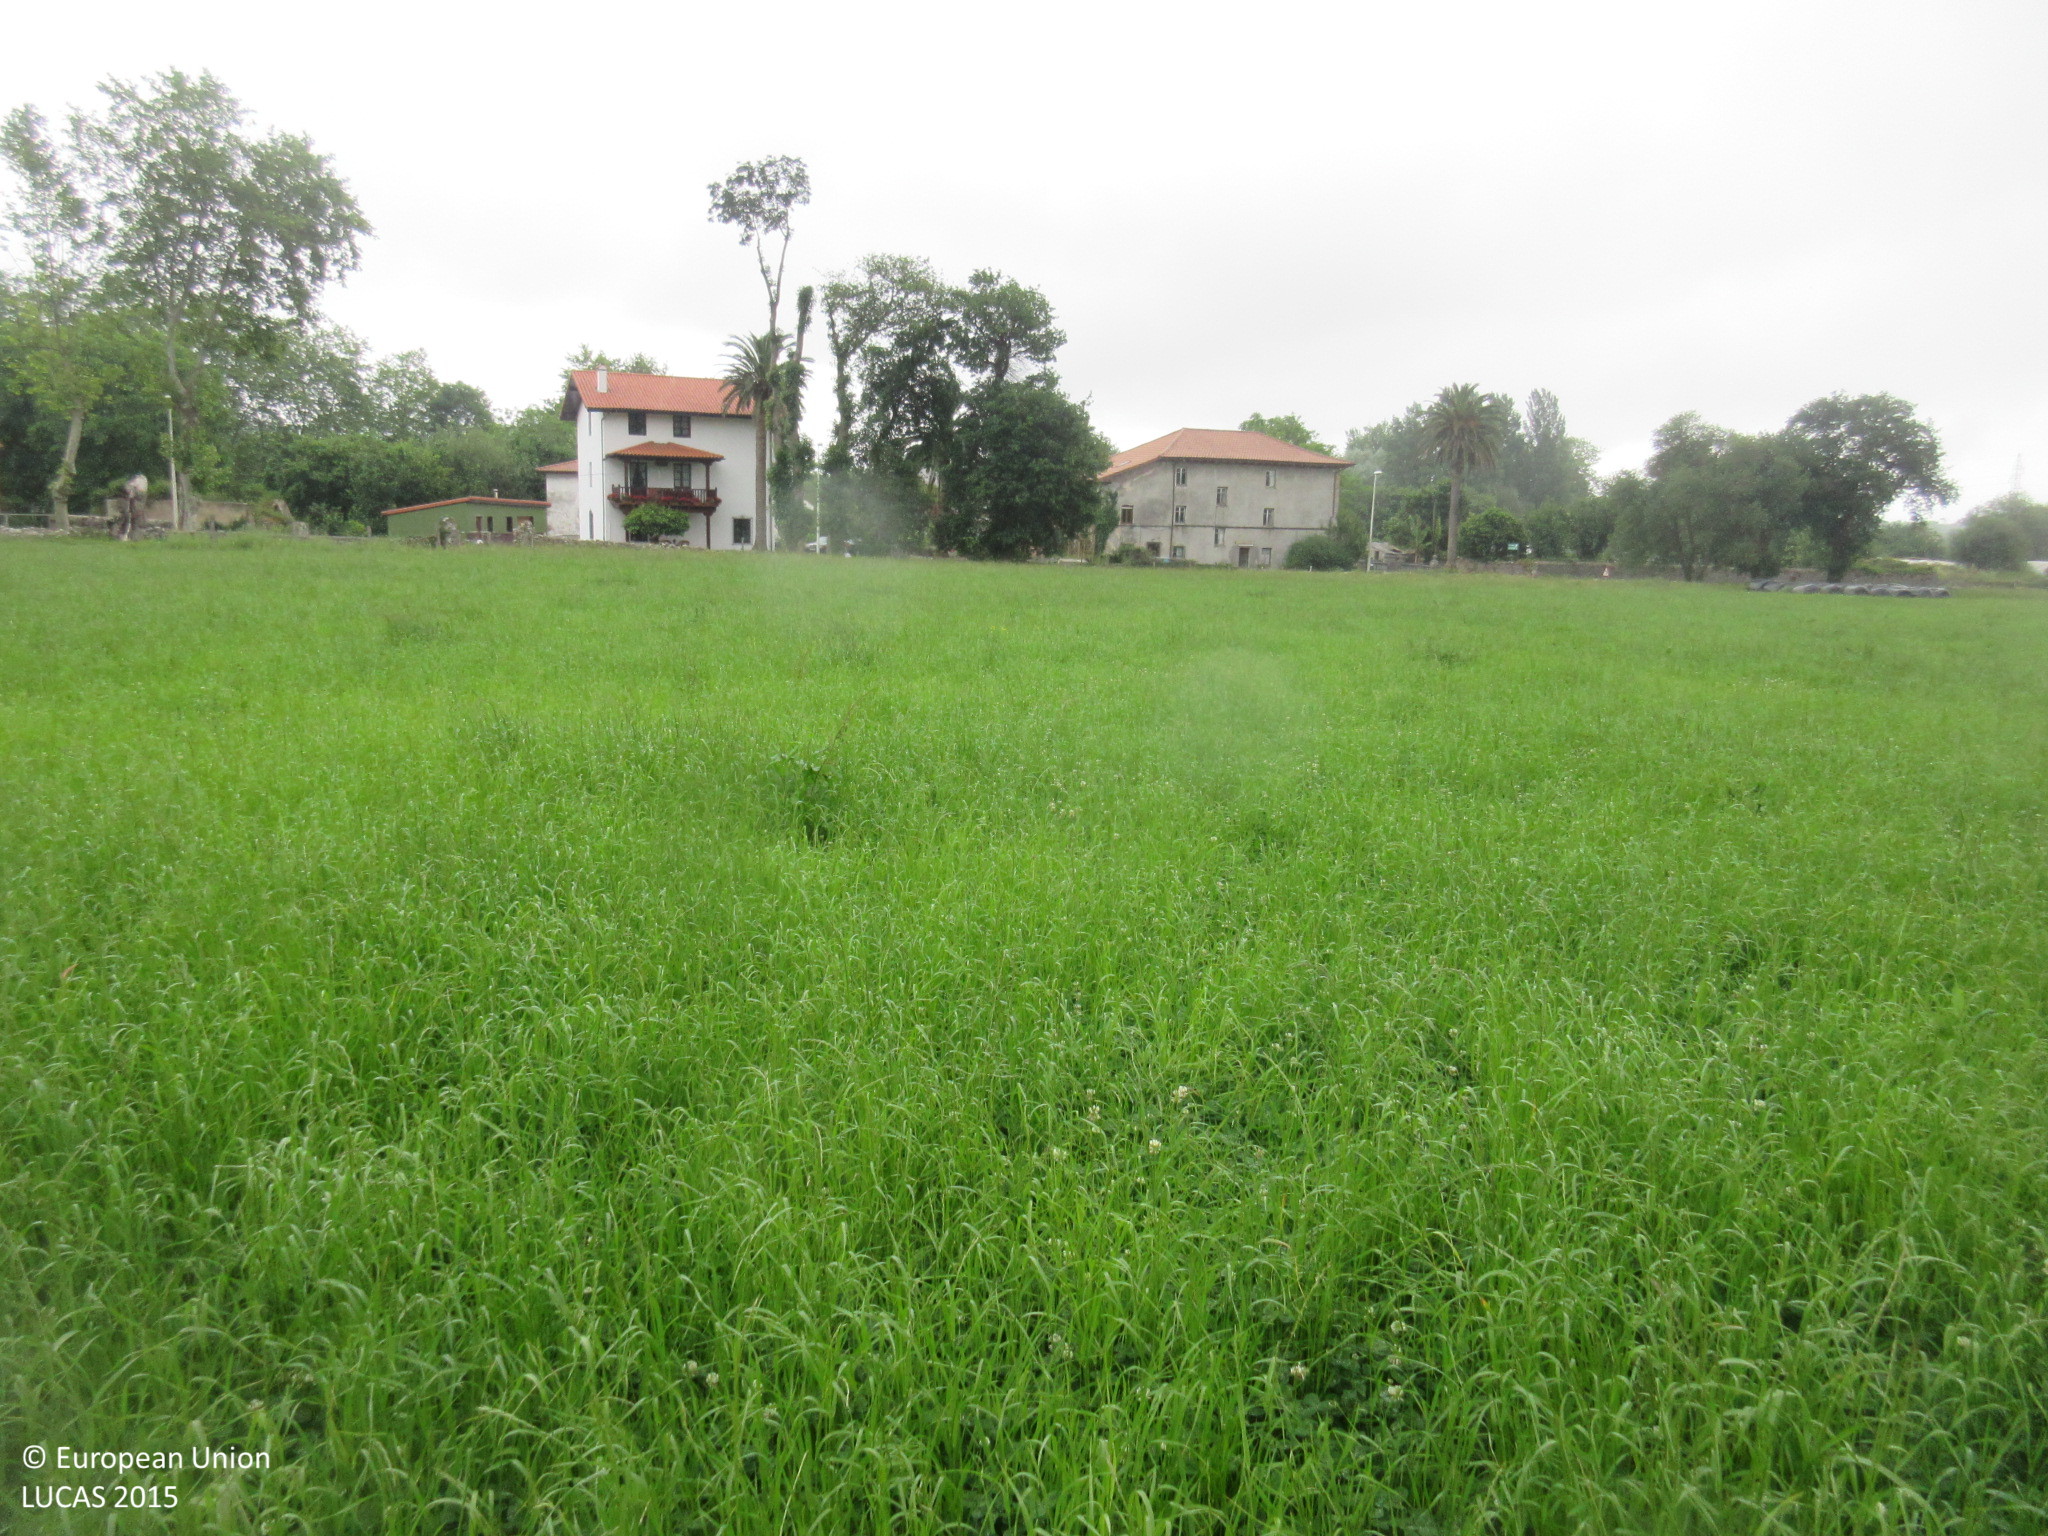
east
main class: Cropland
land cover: Temporary grasslands
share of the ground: > 75 %
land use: Agriculture (excluding fallow land and kitchen gardens)
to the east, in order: Temporary grasslands; Fences; Dry stone walls; Grass margins; Paved roads, cycling and walking lanes; Artificial constructions in urban areas; Grassland without tree/shrub cover; Tracks; Broadleaved woodland
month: June
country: ES
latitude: 43.4422
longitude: -3.5245
